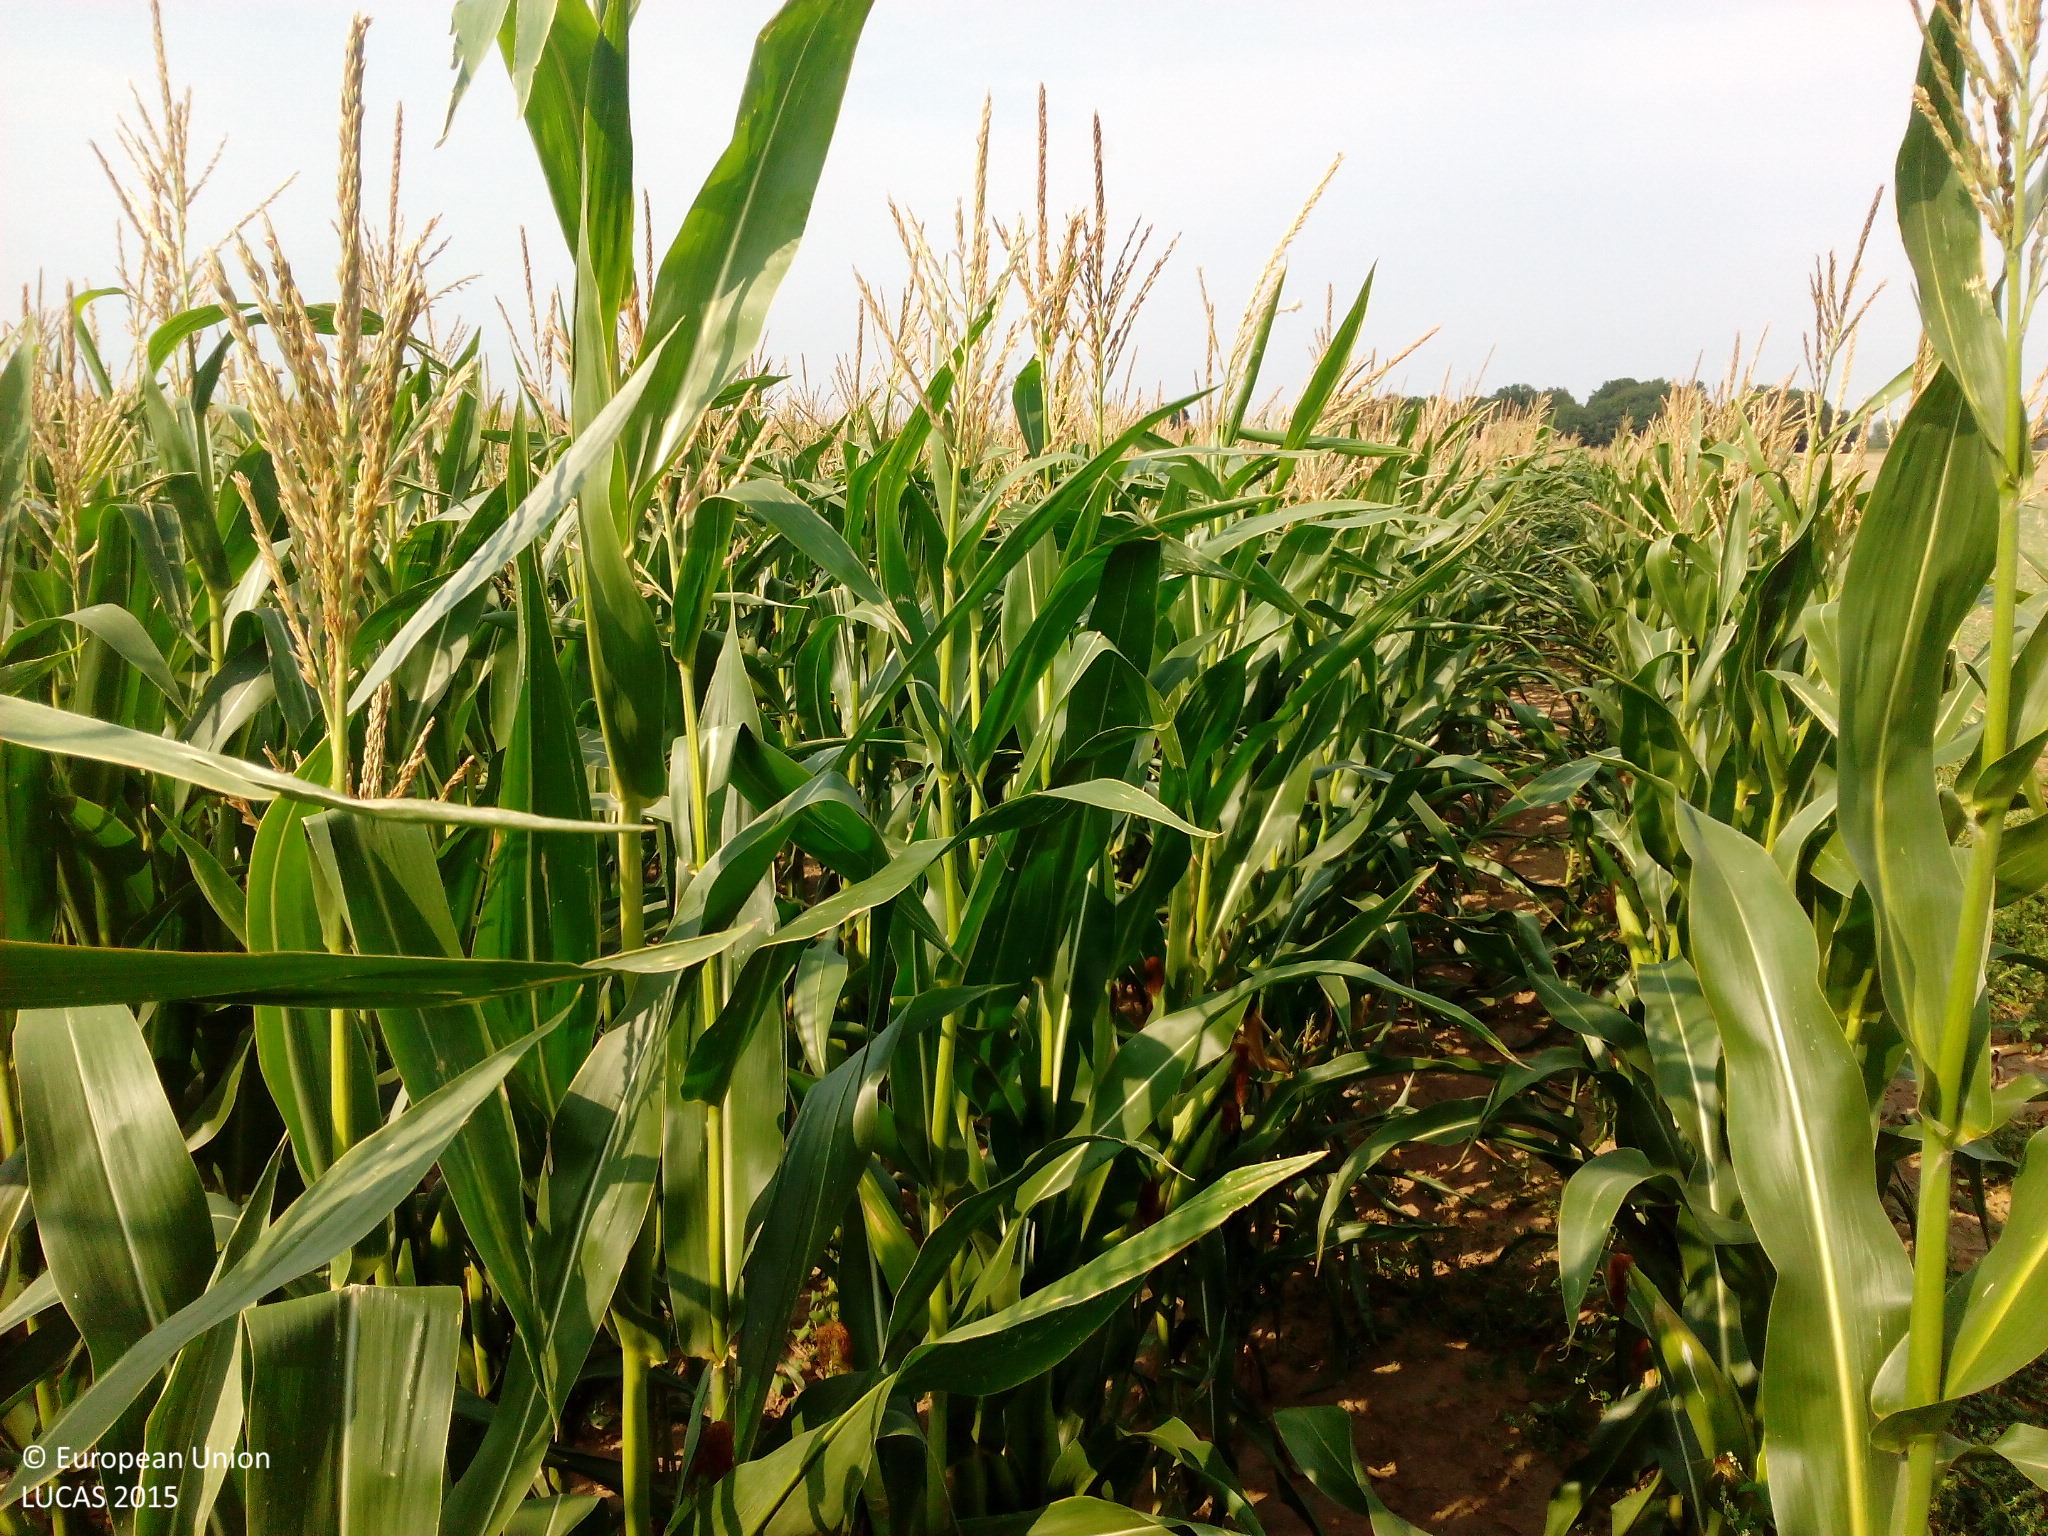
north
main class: Cropland
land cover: Maize
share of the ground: > 75 %
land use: Agriculture (excluding fallow land and kitchen gardens)
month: August
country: DE
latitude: 52.9220
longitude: 11.7397
